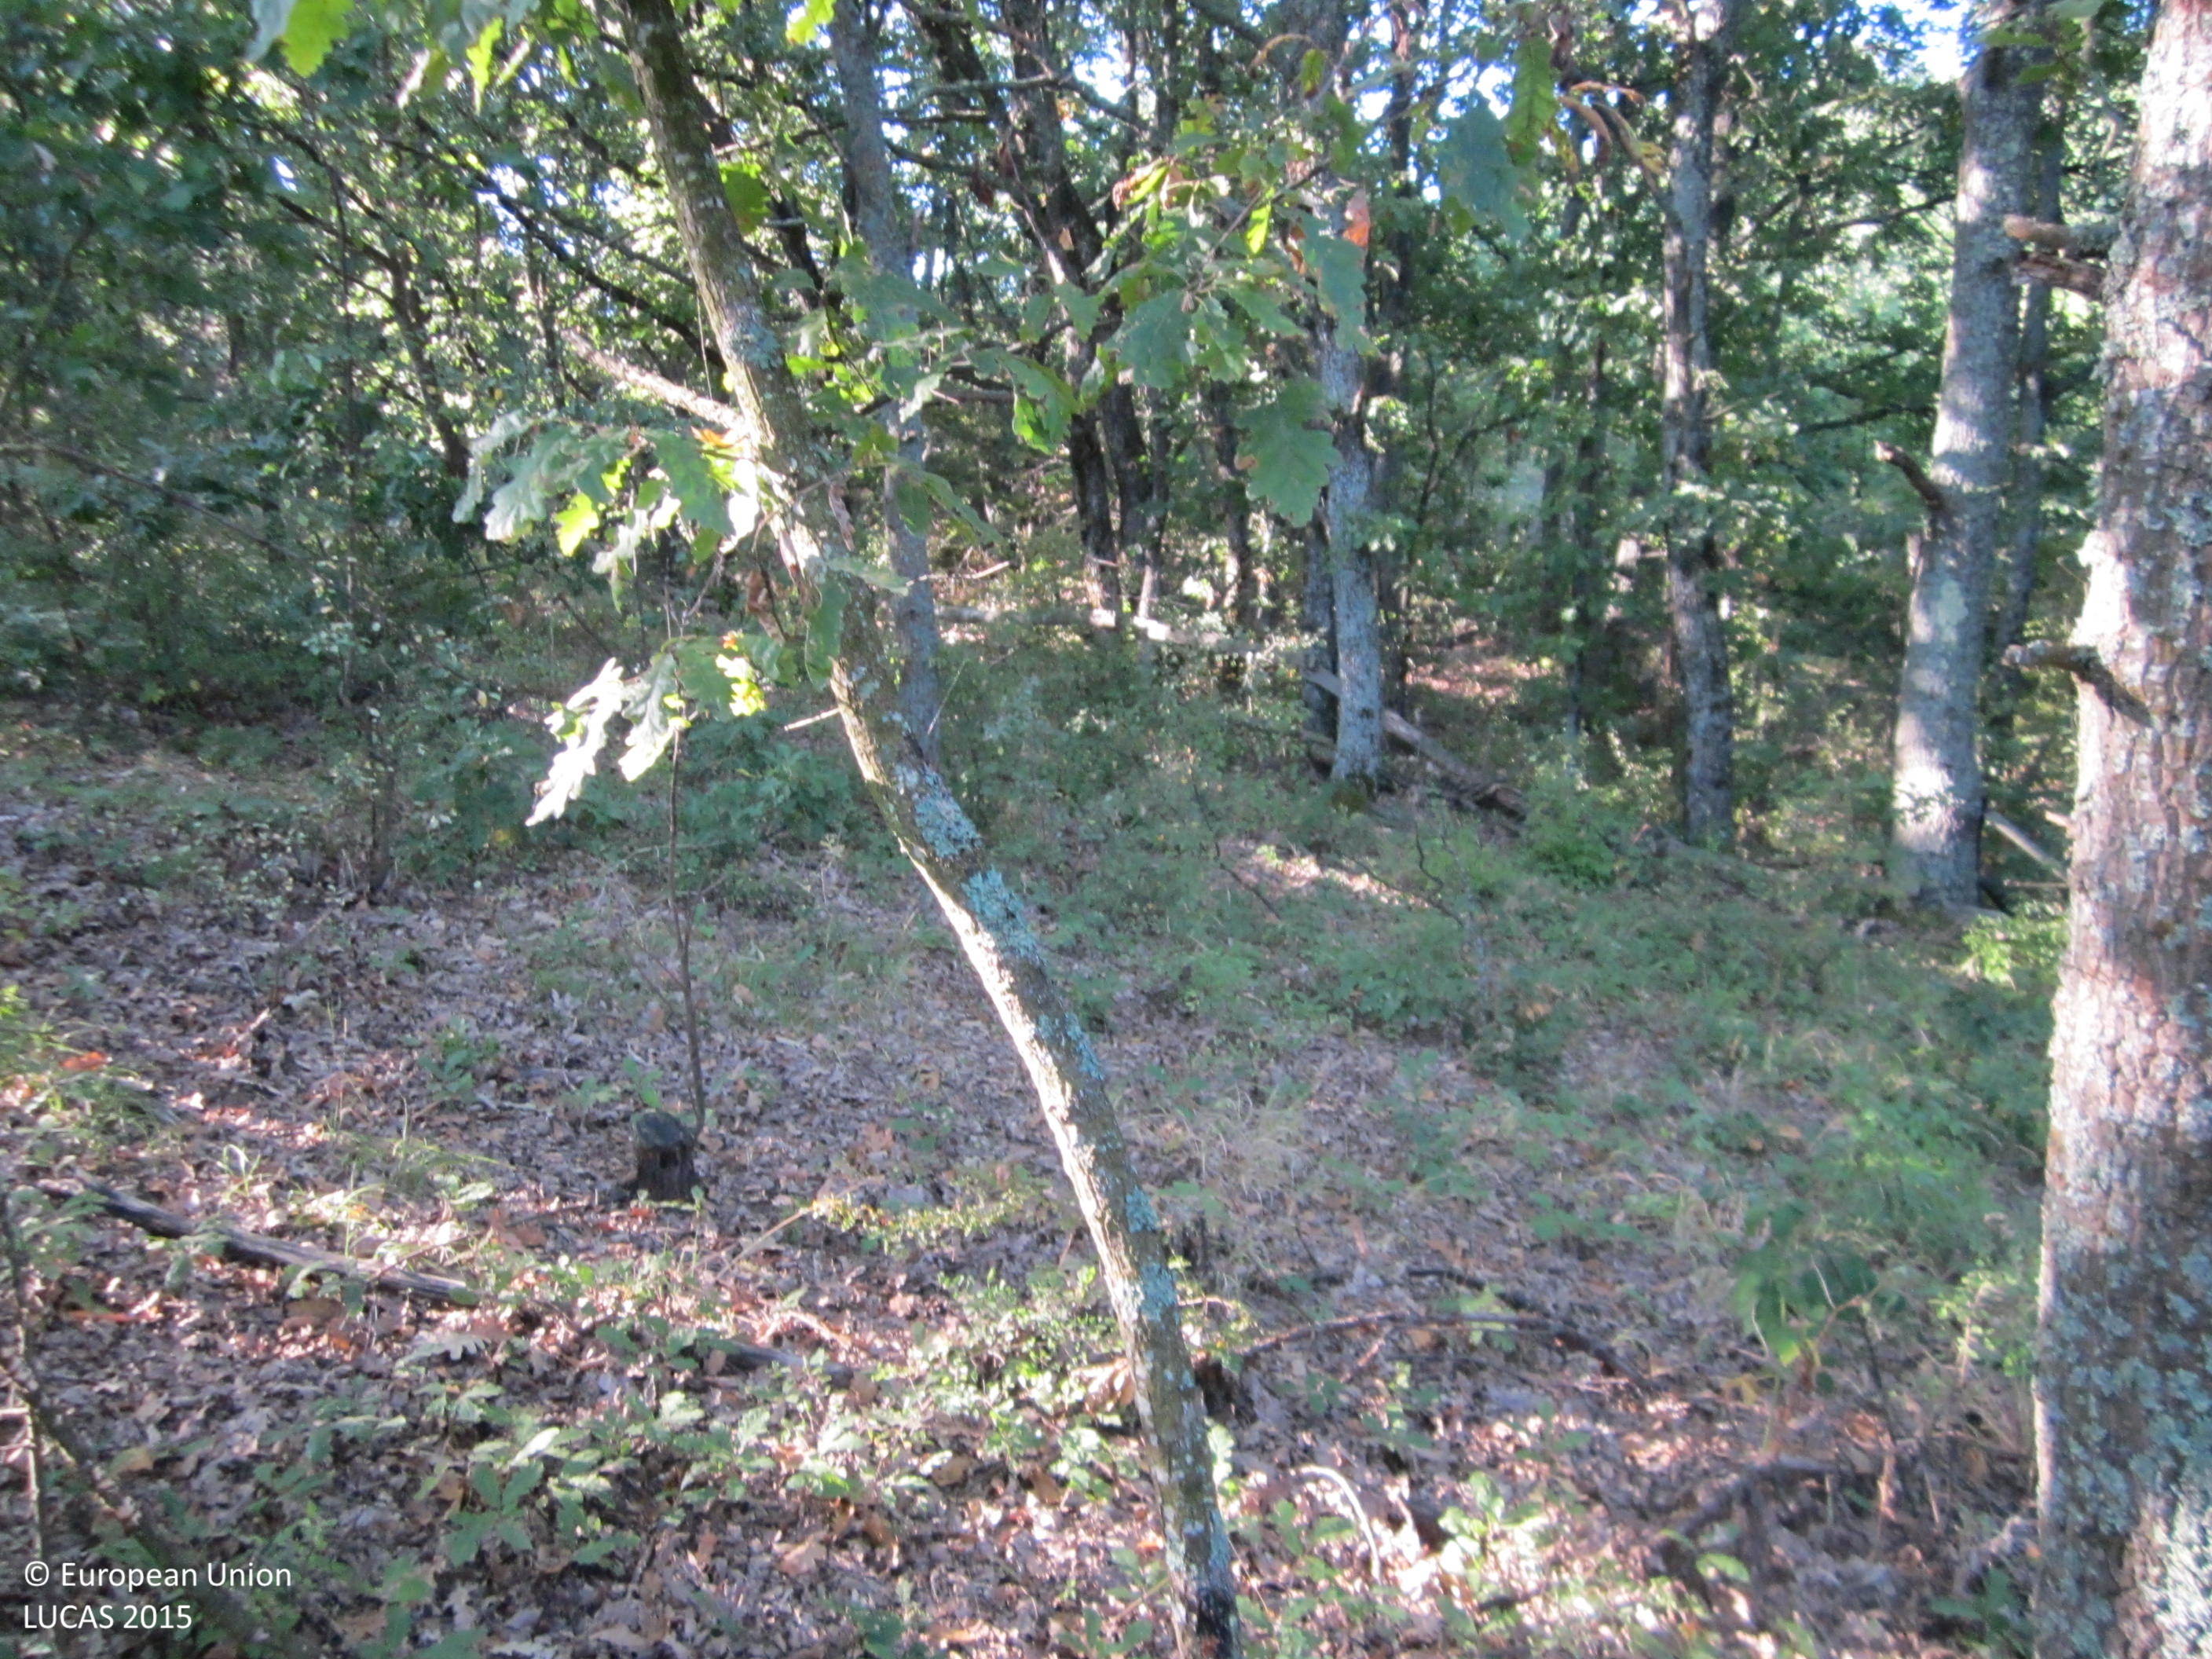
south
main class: Woodland
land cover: Broadleaved woodland
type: thermophilous deciduous forest
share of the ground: > 75 %
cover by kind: broadleaved forest trees 90 %, shrubs 5 %, herbaceous plants 5 %
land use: Forestry
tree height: > 5 m
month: September
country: BG
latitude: 42.1876
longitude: 27.0660
